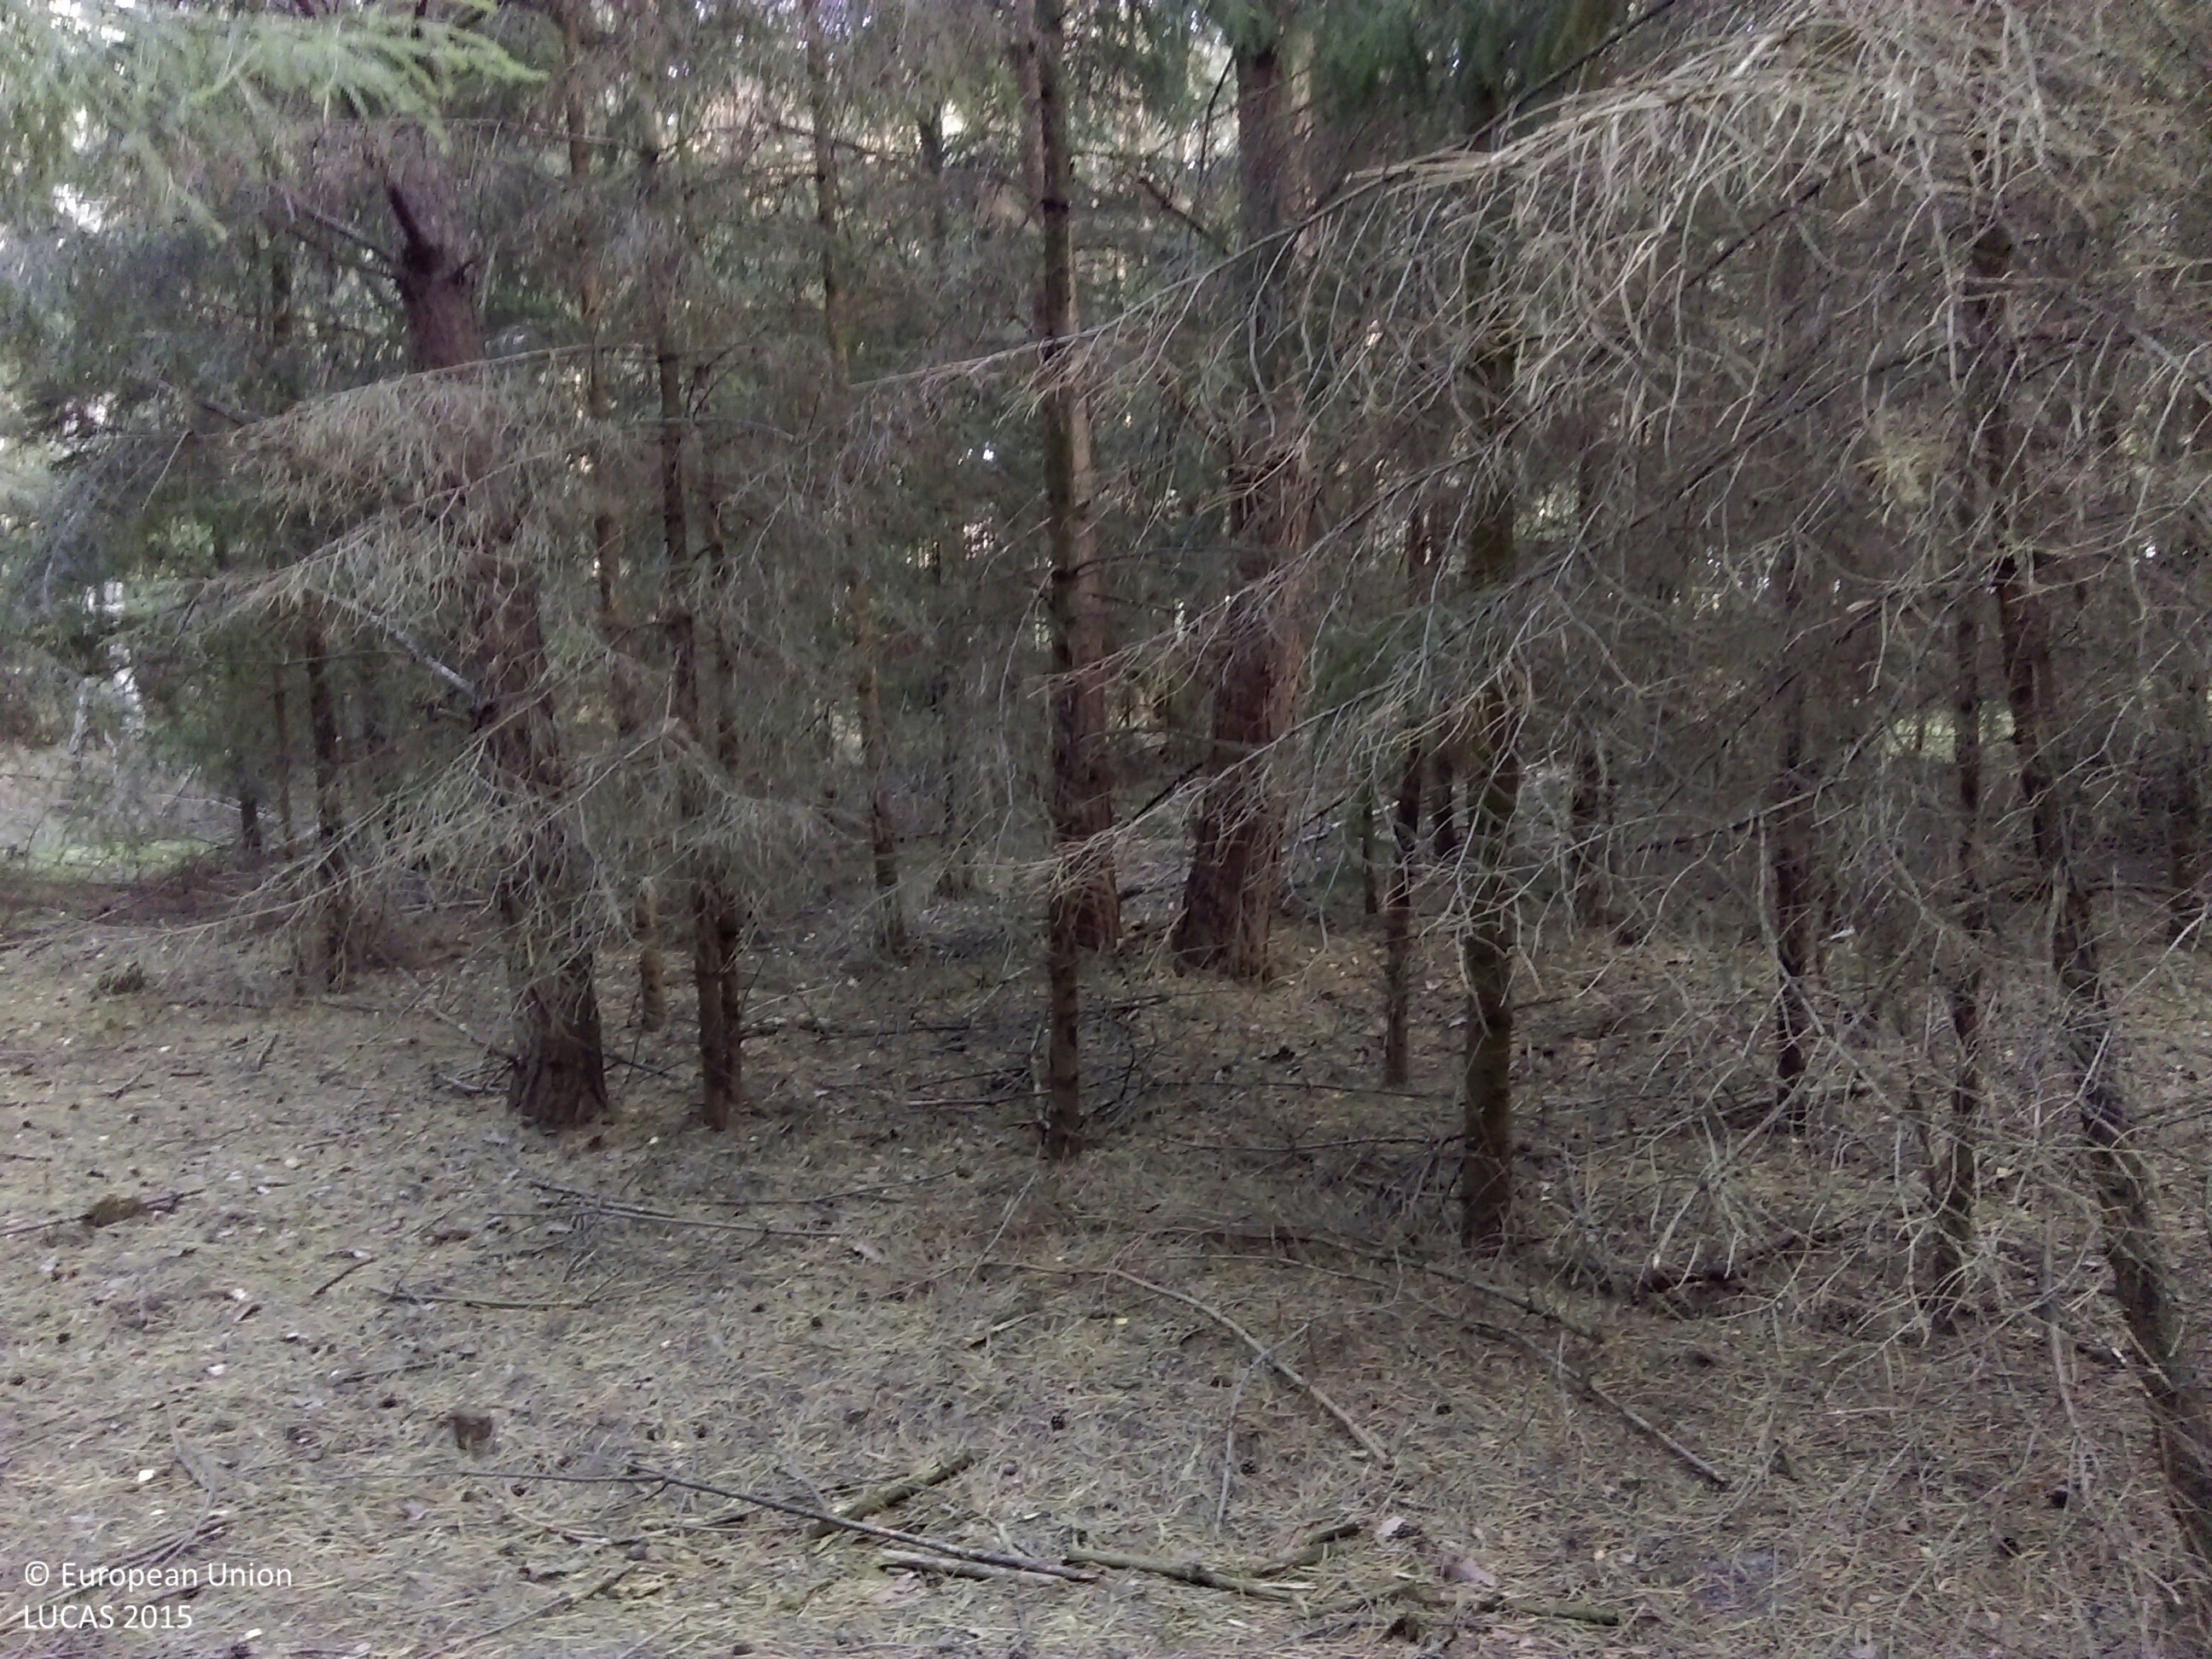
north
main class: Woodland
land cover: Other coniferous woodland
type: hemiboreal forest and nemoral coniferous forest and mixed broadleaved-coniferous forest
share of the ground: > 75 %
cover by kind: coniferous forest trees 75 %, unconsolidated bare surface 25 %
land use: Forestry
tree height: > 5 m
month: September
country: PL
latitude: 52.1230
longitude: 16.2433
